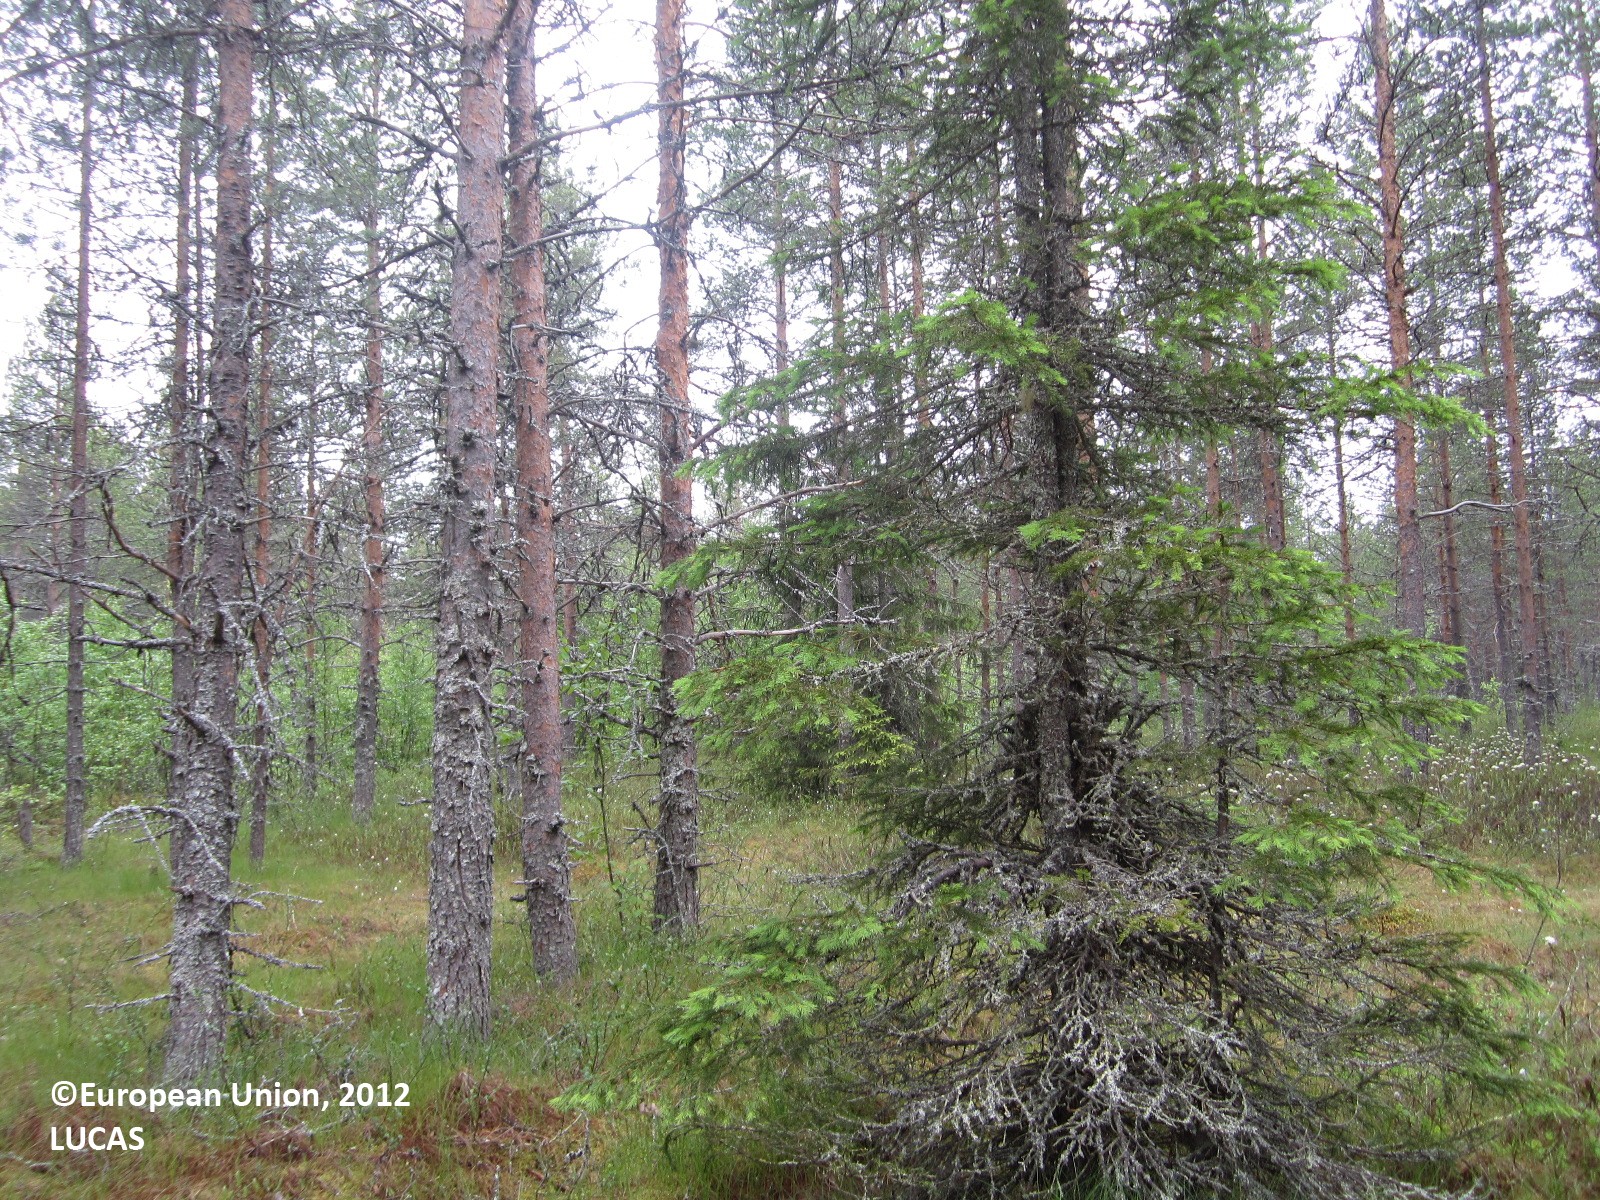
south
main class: Woodland
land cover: Pine dominated coniferous woodland
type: boreal forest
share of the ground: 50 - 75 %
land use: Forestry
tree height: > 5 m
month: June
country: FI
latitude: 64.4410
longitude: 29.2109
